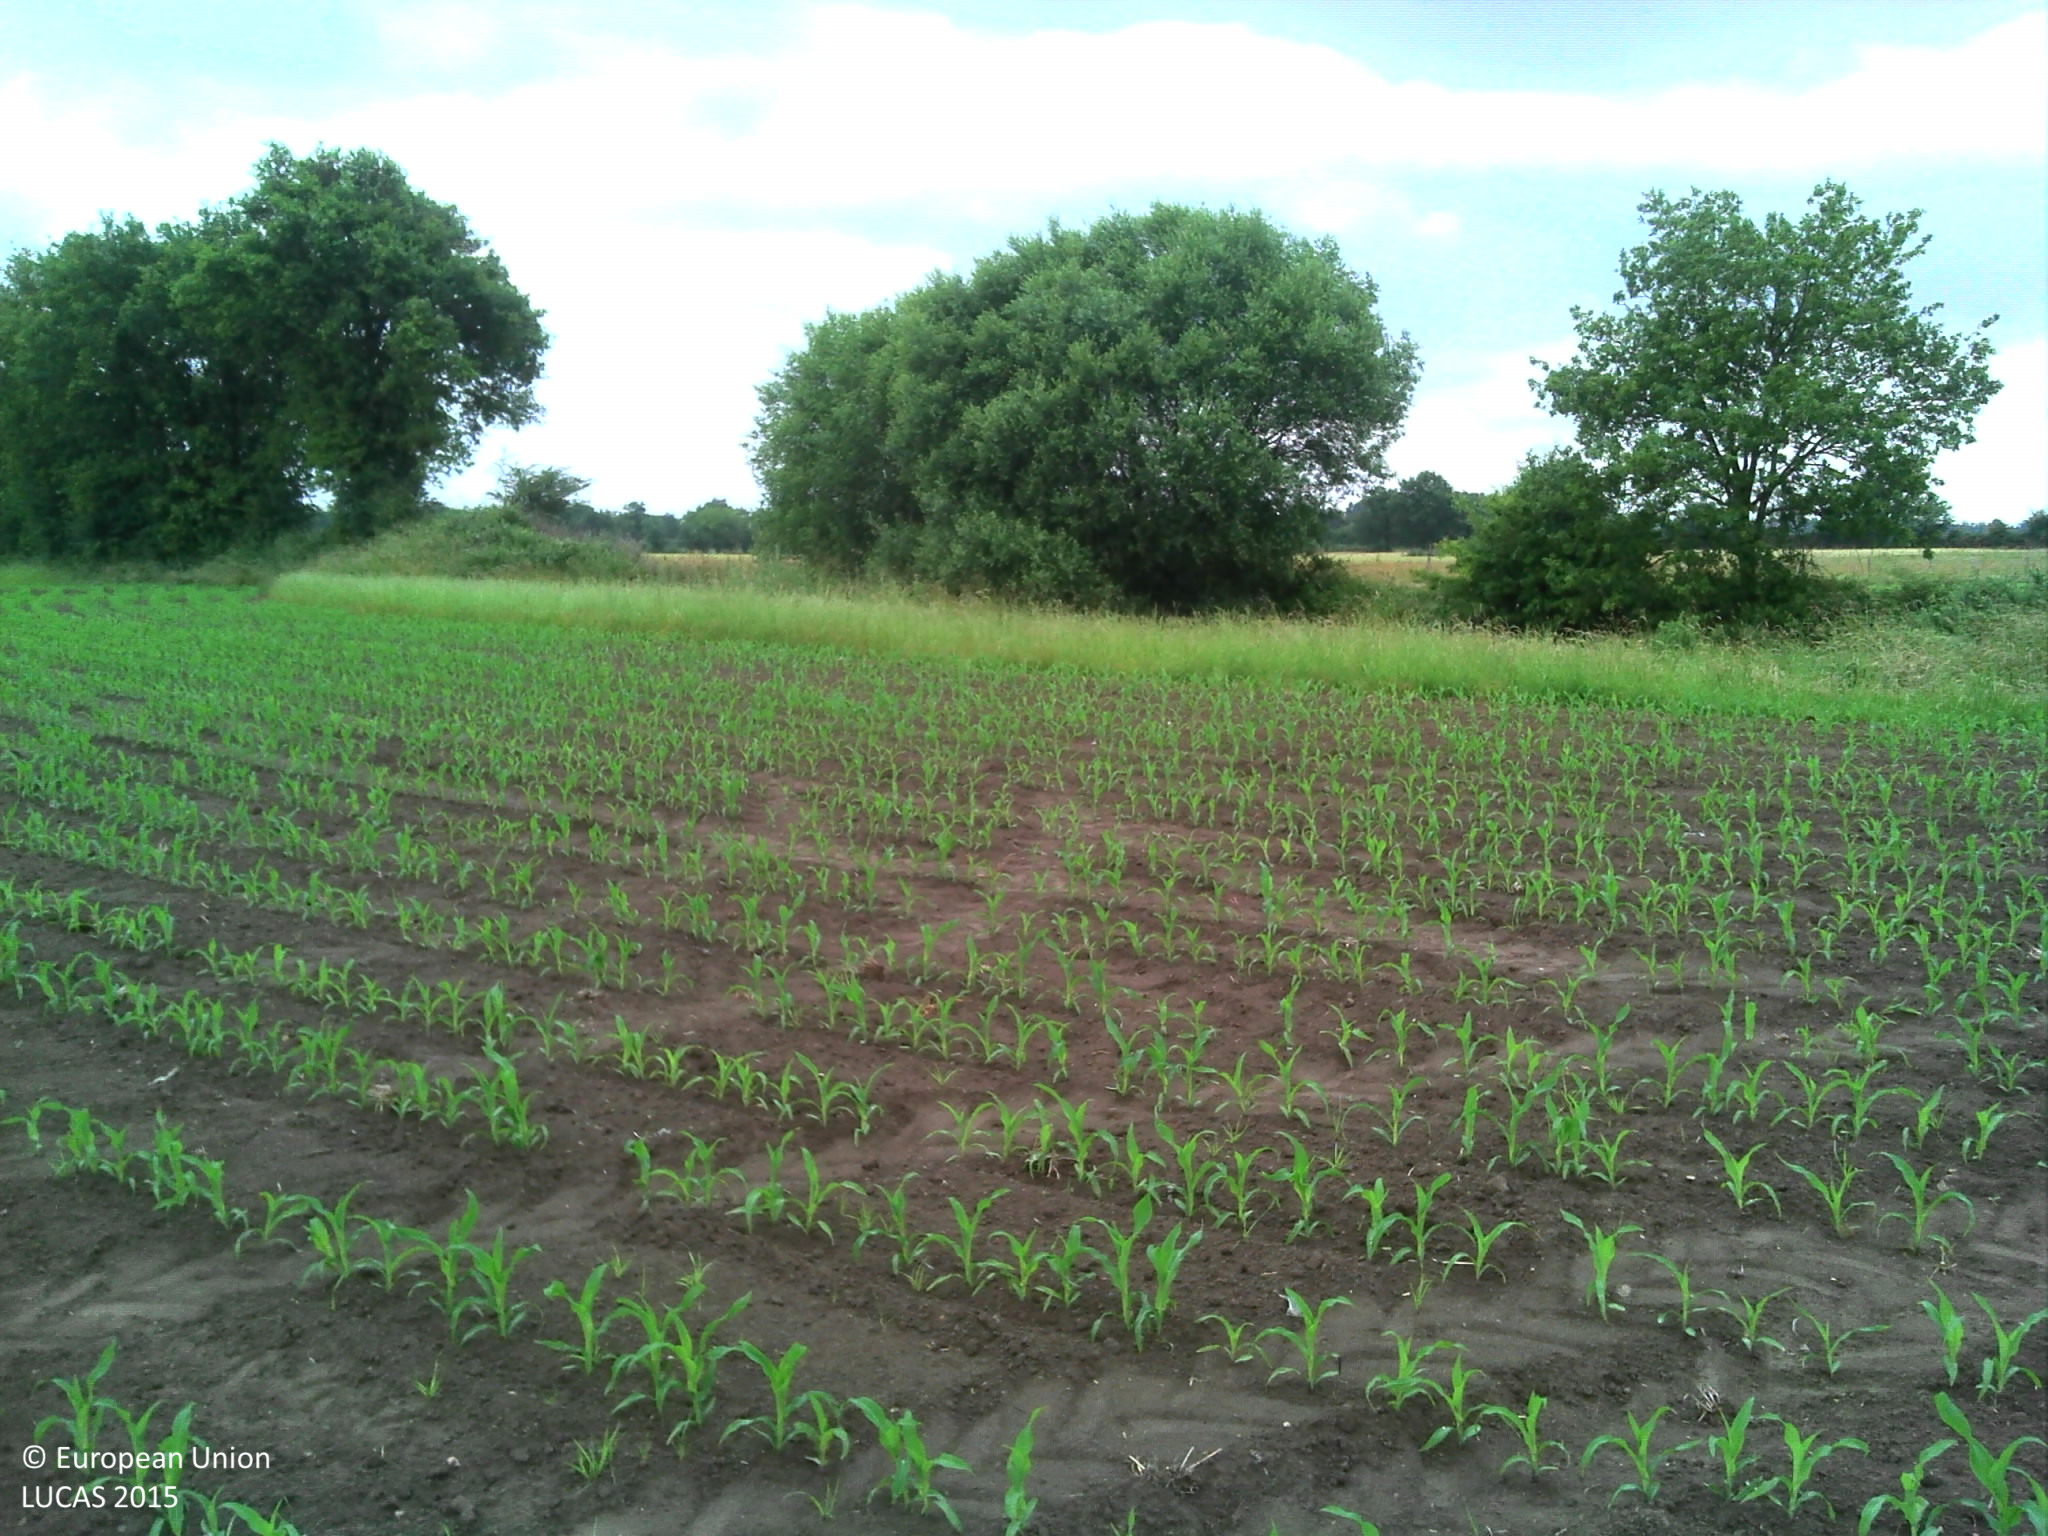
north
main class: Cropland
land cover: Maize
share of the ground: 10 - 25 %
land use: Agriculture (excluding fallow land and kitchen gardens)
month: June
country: FR
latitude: 46.8954
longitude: -1.4719
